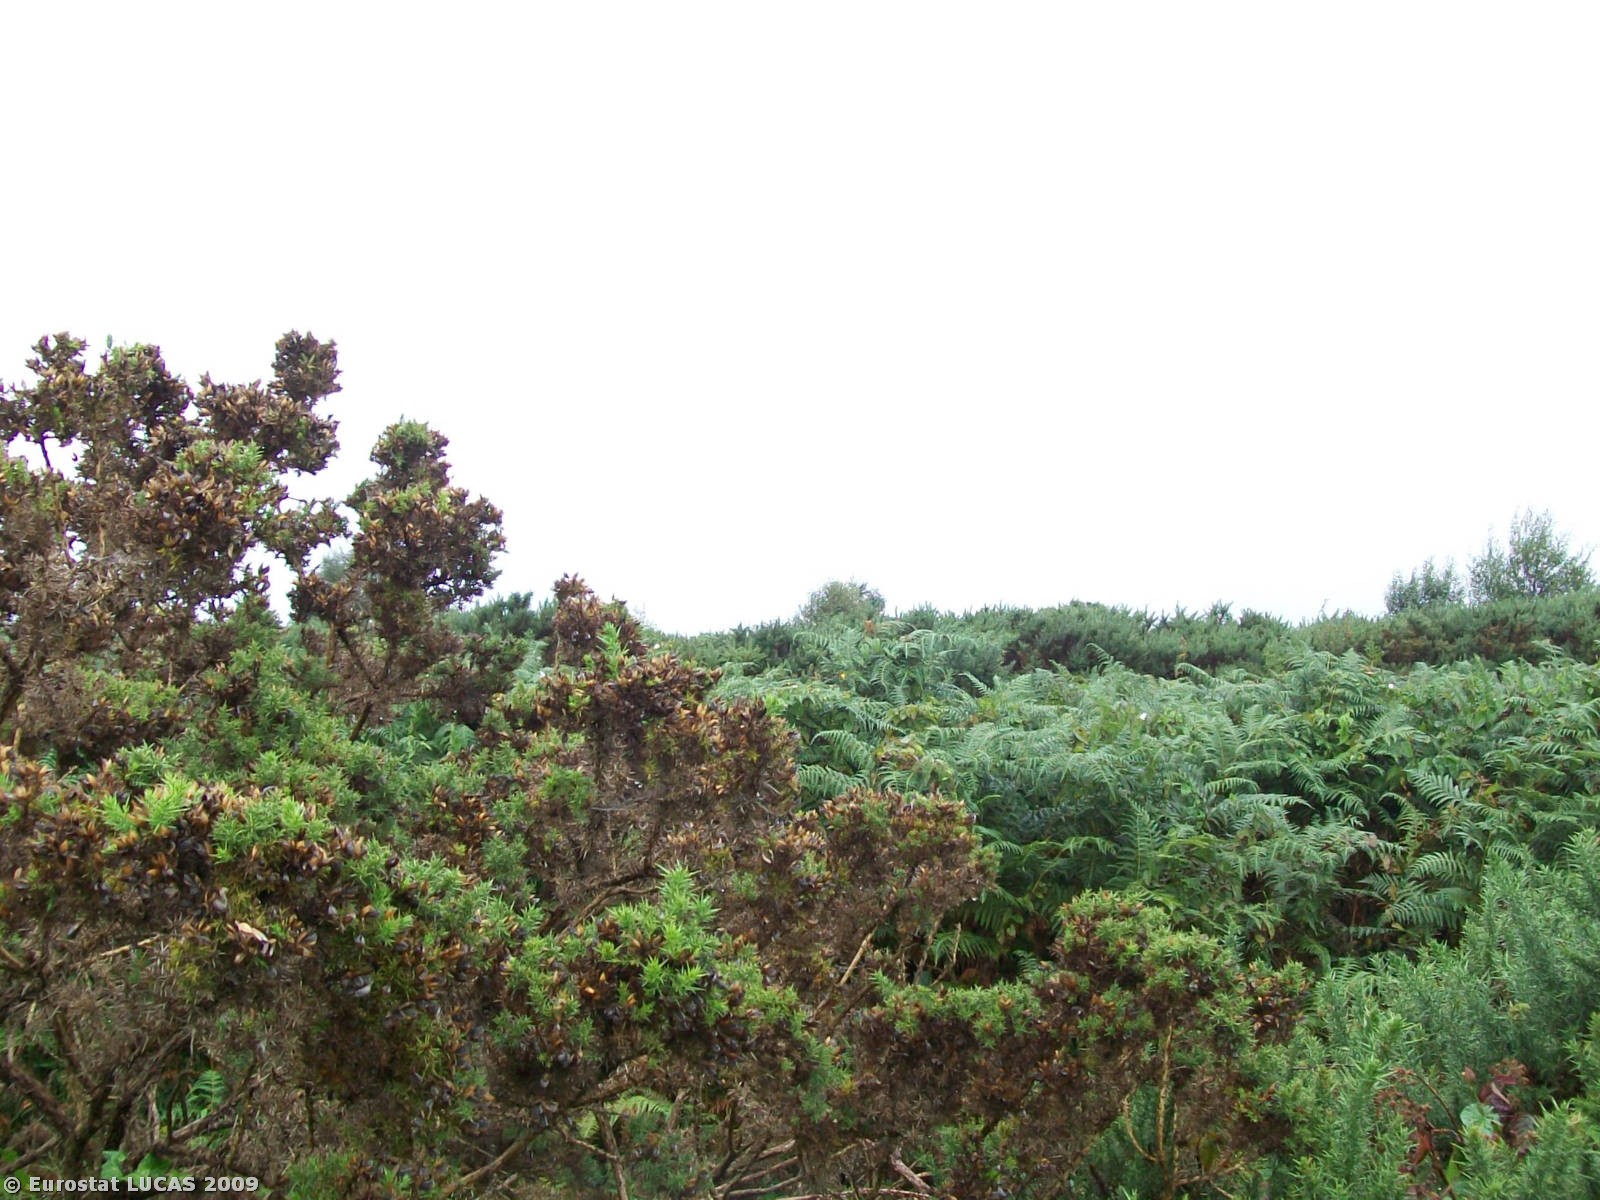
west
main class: Shrubland
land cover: Shrubland without tree cover
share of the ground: > 75 %
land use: Fallow land
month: September
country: IE
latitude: 53.1942
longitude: -7.9093
